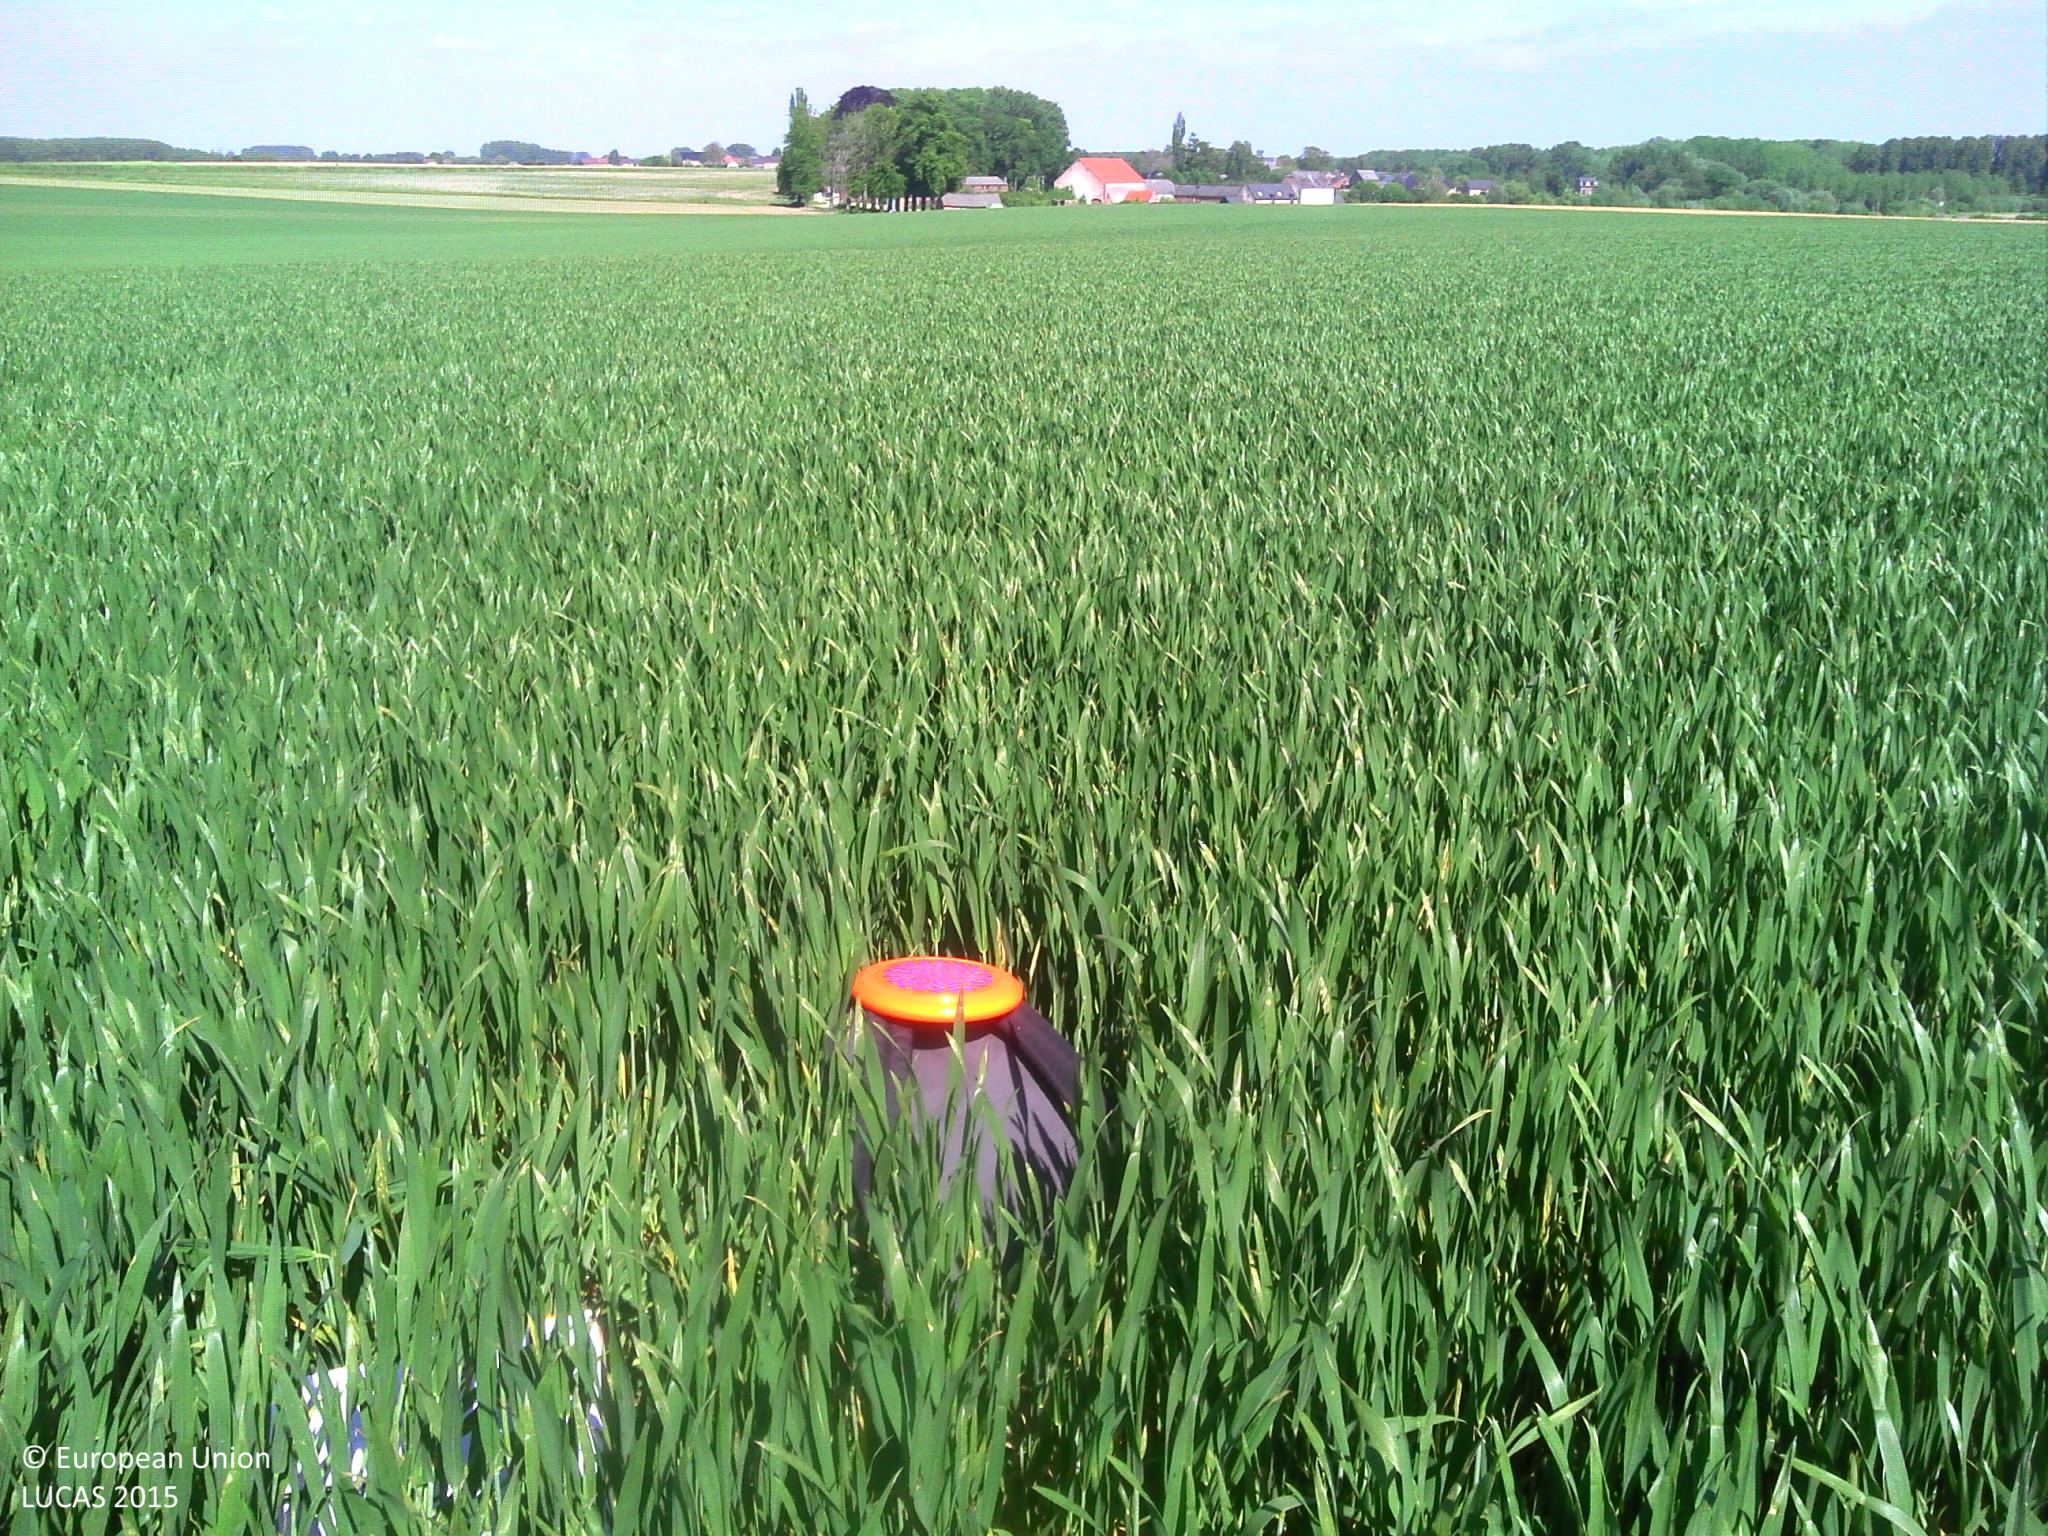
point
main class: Cropland
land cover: Common wheat
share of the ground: > 75 %
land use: Agriculture (excluding fallow land and kitchen gardens)
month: May
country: BE
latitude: 50.6092
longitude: 4.8672
